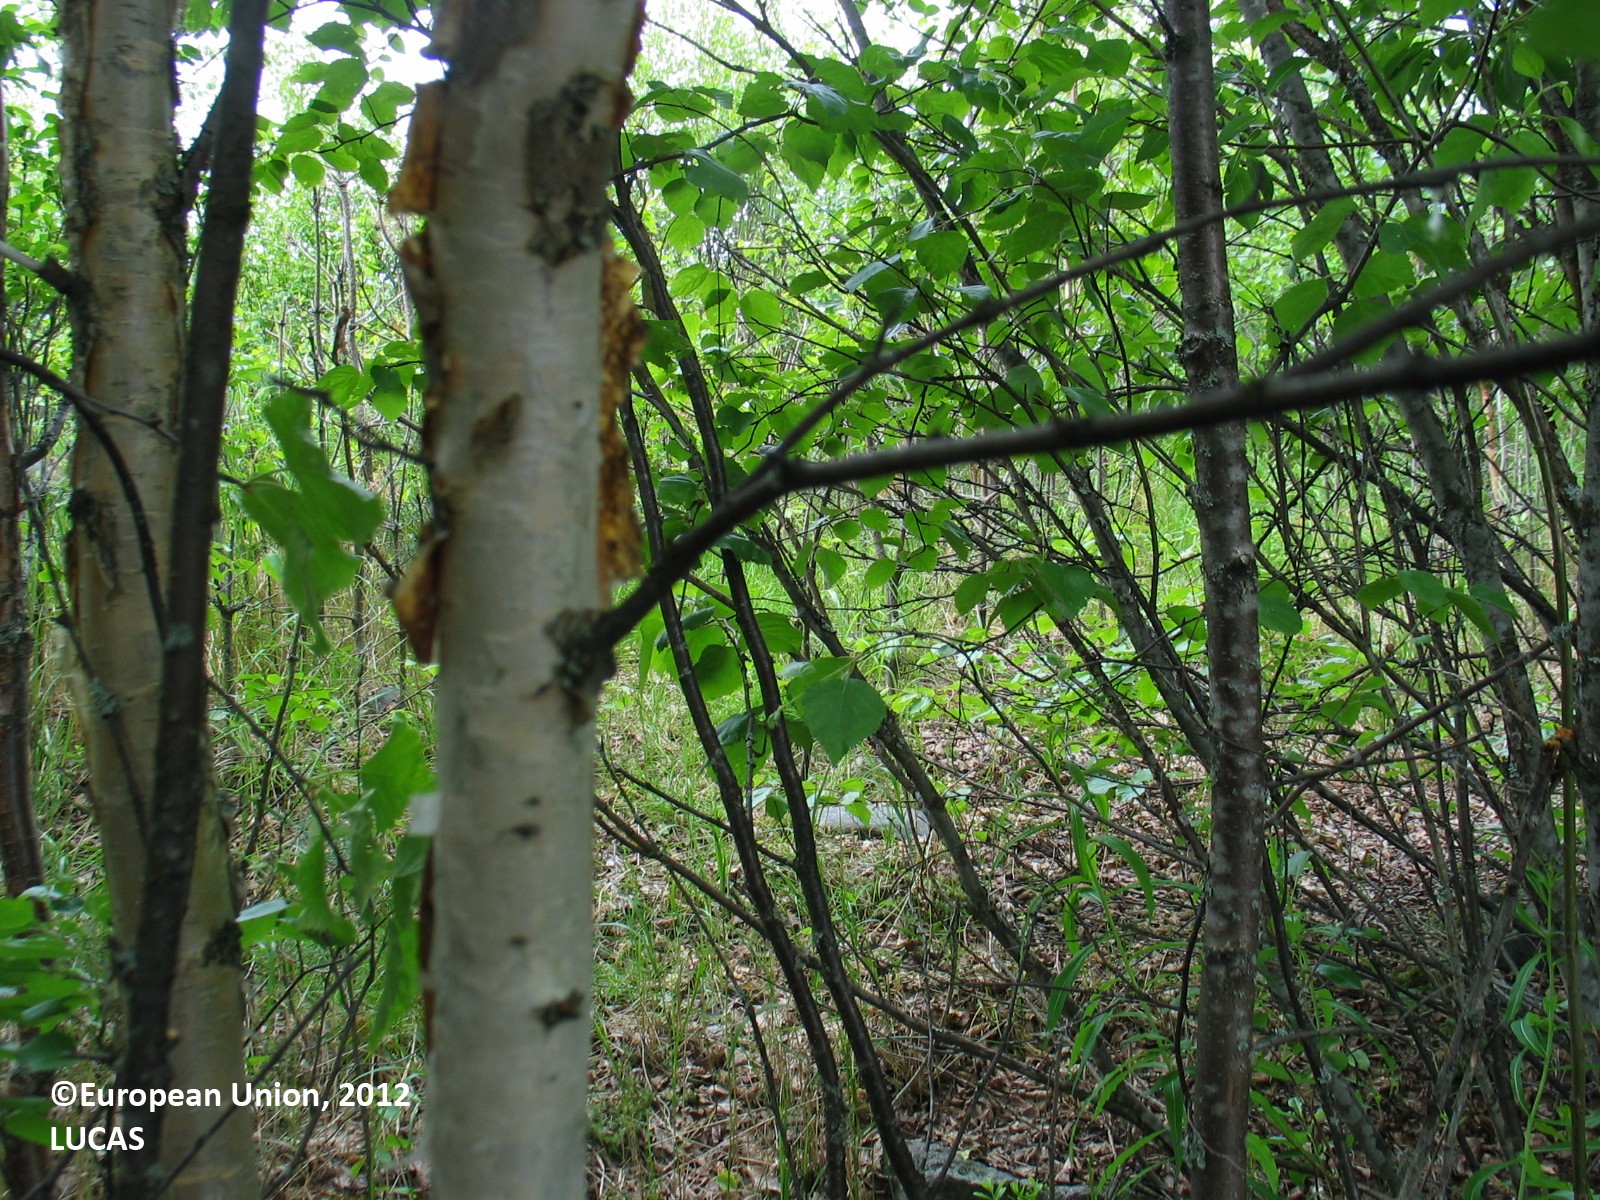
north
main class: Woodland
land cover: Pine dominated coniferous woodland
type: mire and swamp forests
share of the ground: 10 - 25 %
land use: Semi-natural and natural areas not in use
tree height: > 5 m
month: June
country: FI
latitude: 64.8172
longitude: 26.5622
